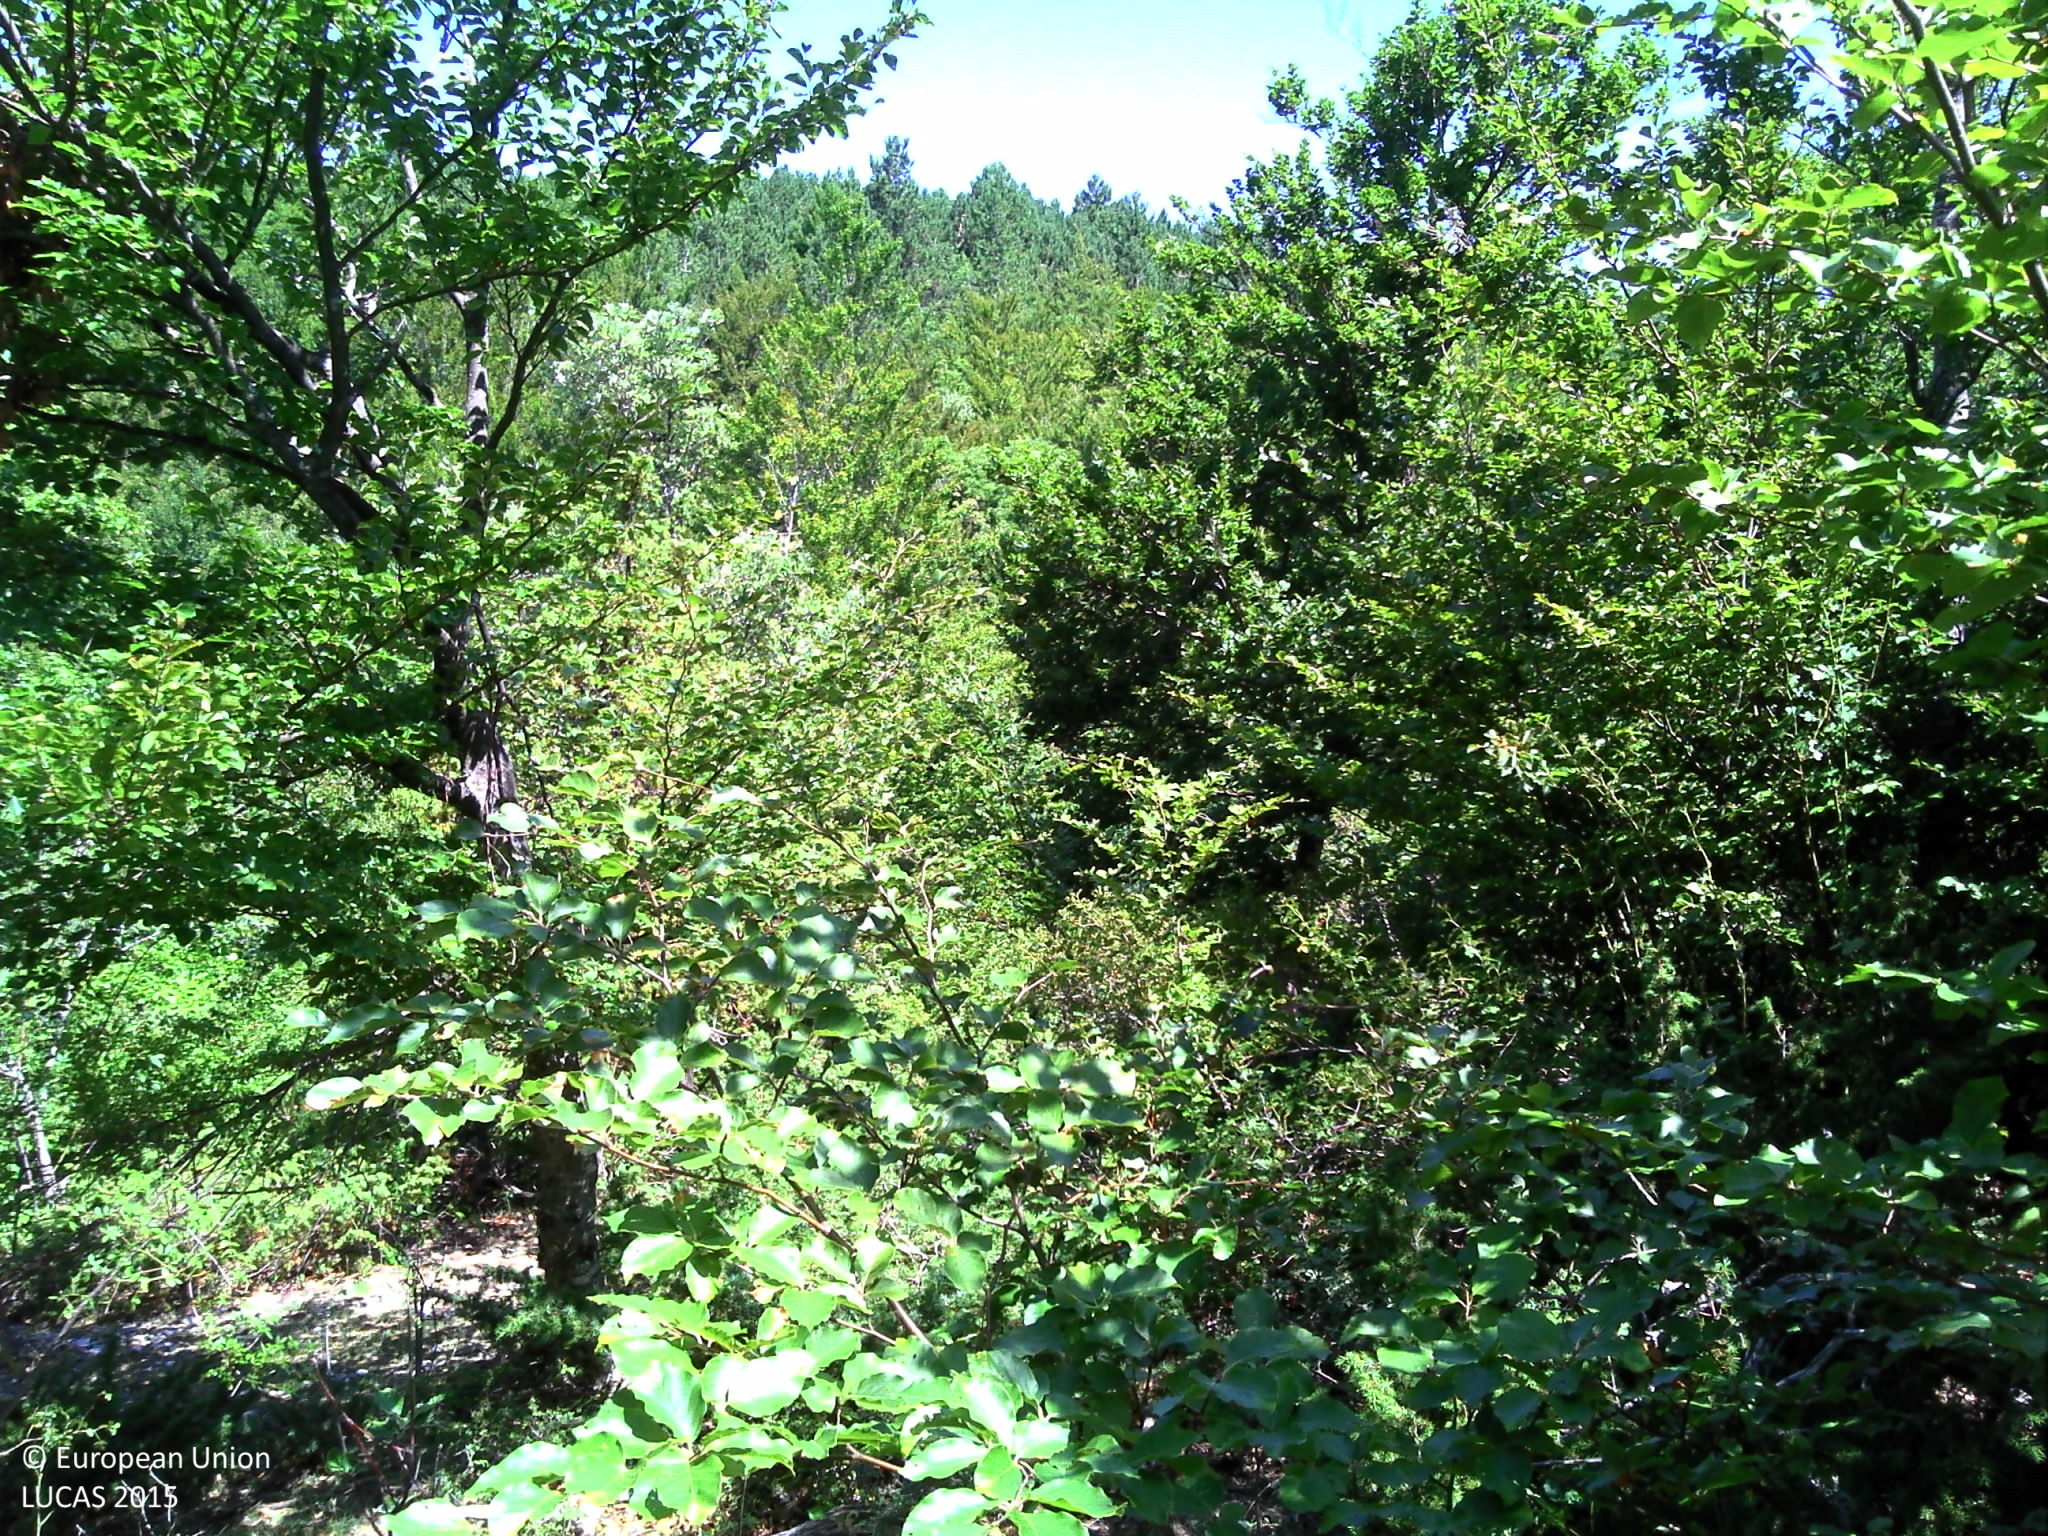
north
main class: Woodland
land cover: Broadleaved woodland
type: broadleaved evergreen forest
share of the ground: > 75 %
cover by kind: broadleaved forest trees 75 %, shrubs 20 %, herbaceous plants 5 %
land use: Semi-natural and natural areas not in use
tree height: > 5 m
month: July
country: FR
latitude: 44.1355
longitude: 5.2957
